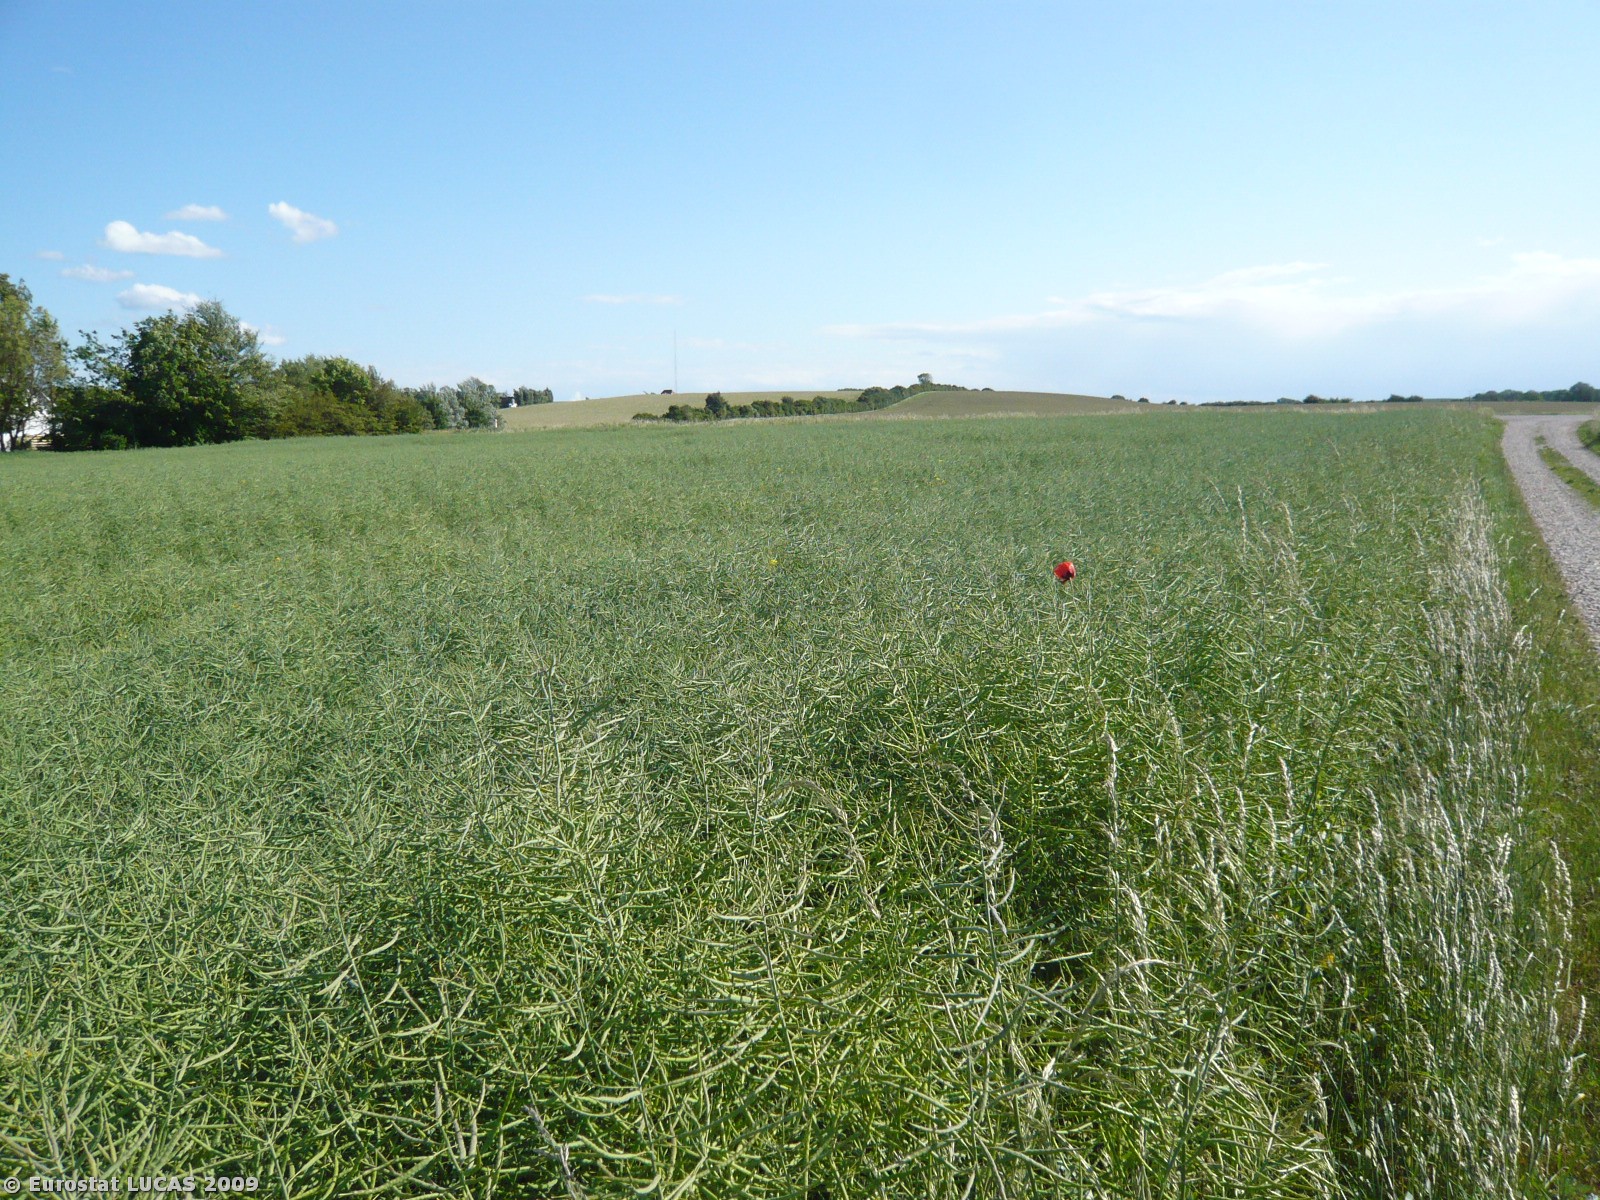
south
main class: Cropland
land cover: Rape and turnip rape
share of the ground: > 75 %
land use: Agriculture (excluding fallow land and kitchen gardens)
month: June
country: DK
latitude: 55.3191
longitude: 11.2124
